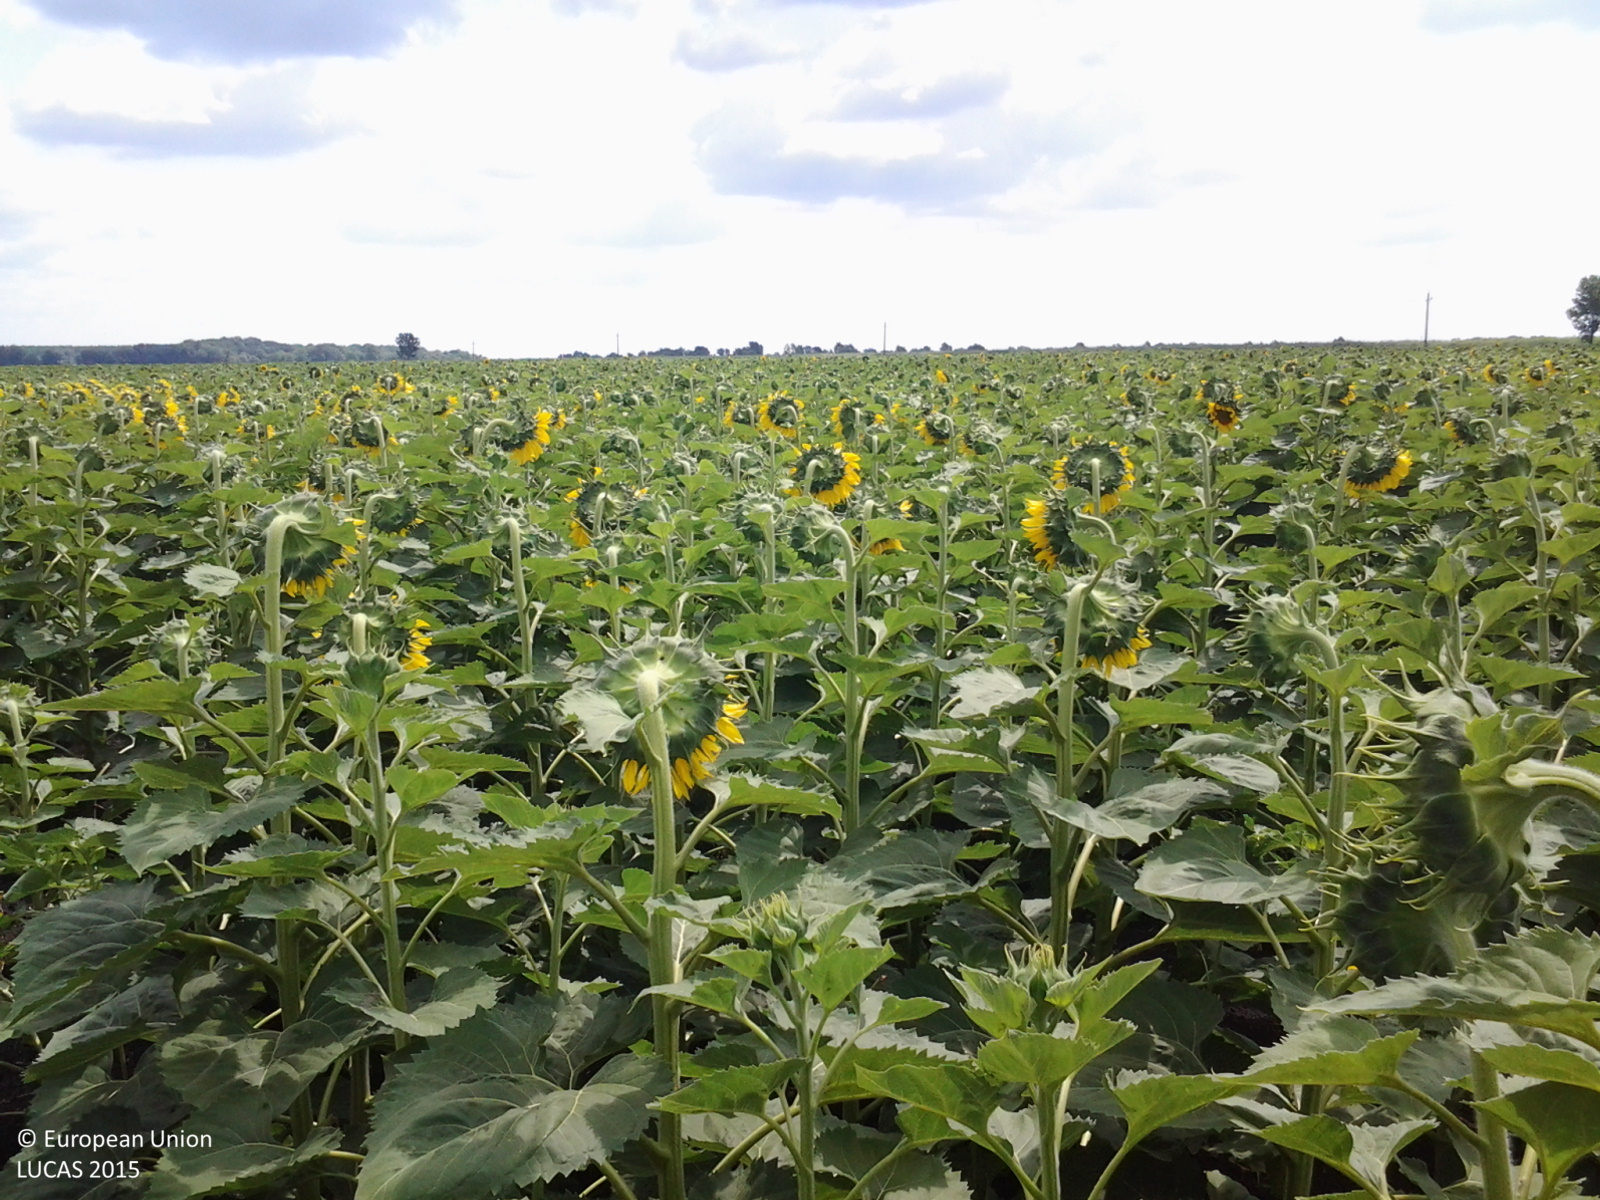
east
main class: Cropland
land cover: Sunflower
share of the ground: > 75 %
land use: Agriculture (excluding fallow land and kitchen gardens)
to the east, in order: Sunflower
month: July
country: HU
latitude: 46.9200
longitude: 20.7066
